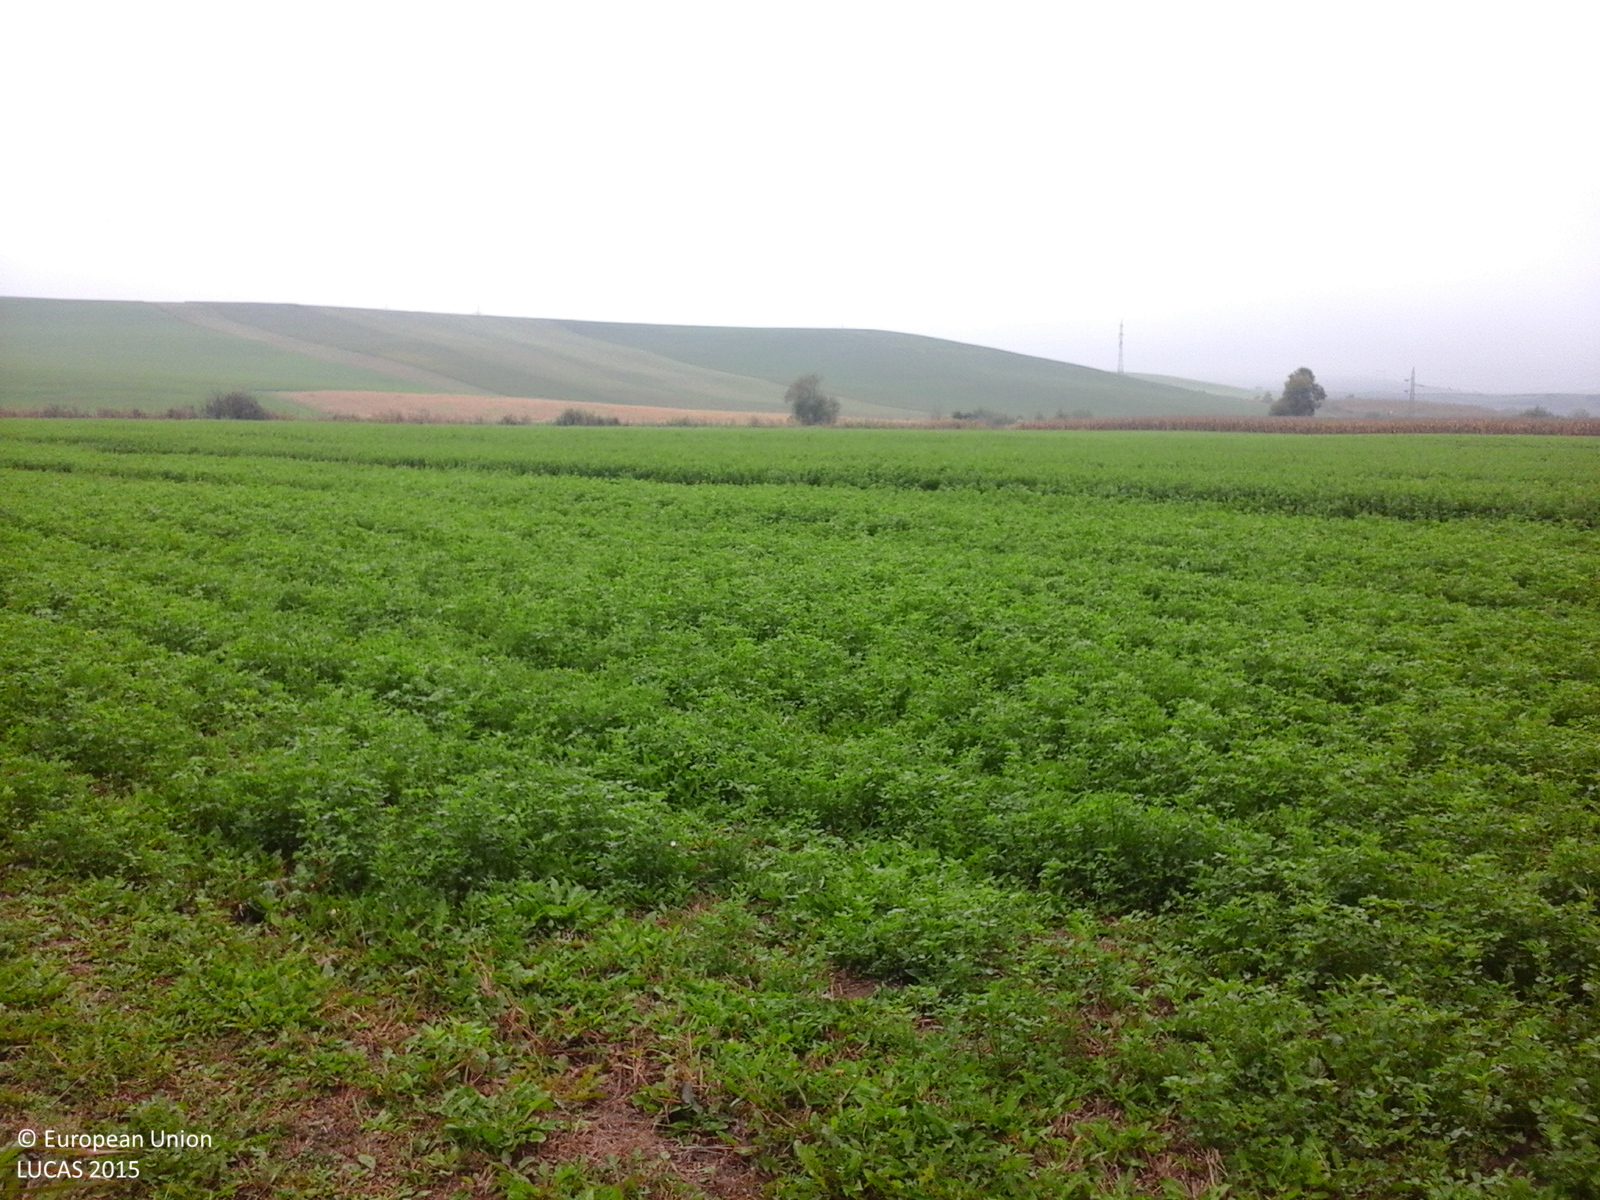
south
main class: Cropland
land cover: Maize
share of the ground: > 75 %
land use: Agriculture (excluding fallow land and kitchen gardens)
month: October
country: RO
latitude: 46.2419
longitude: 24.1759
